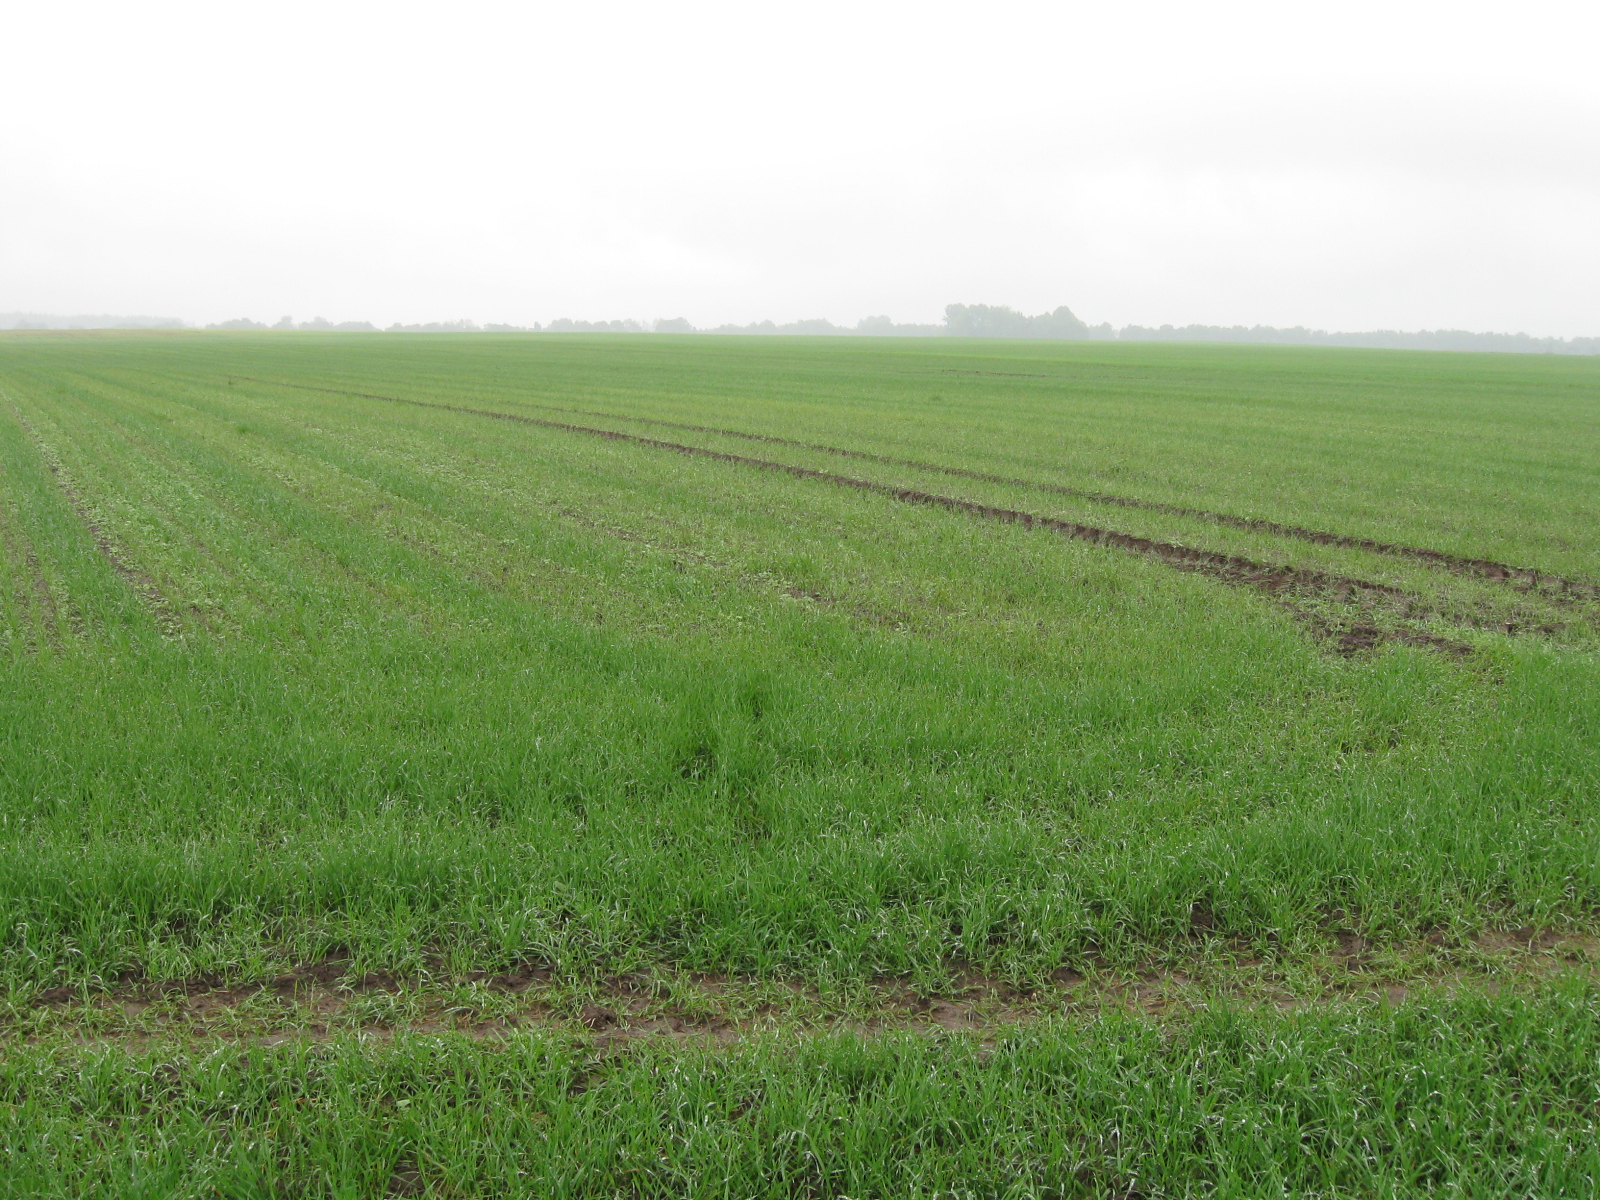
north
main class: Cropland
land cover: Common wheat
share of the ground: > 75 %
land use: Agriculture (excluding fallow land and kitchen gardens)
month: May
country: LT
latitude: 55.0052
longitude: 22.7149
